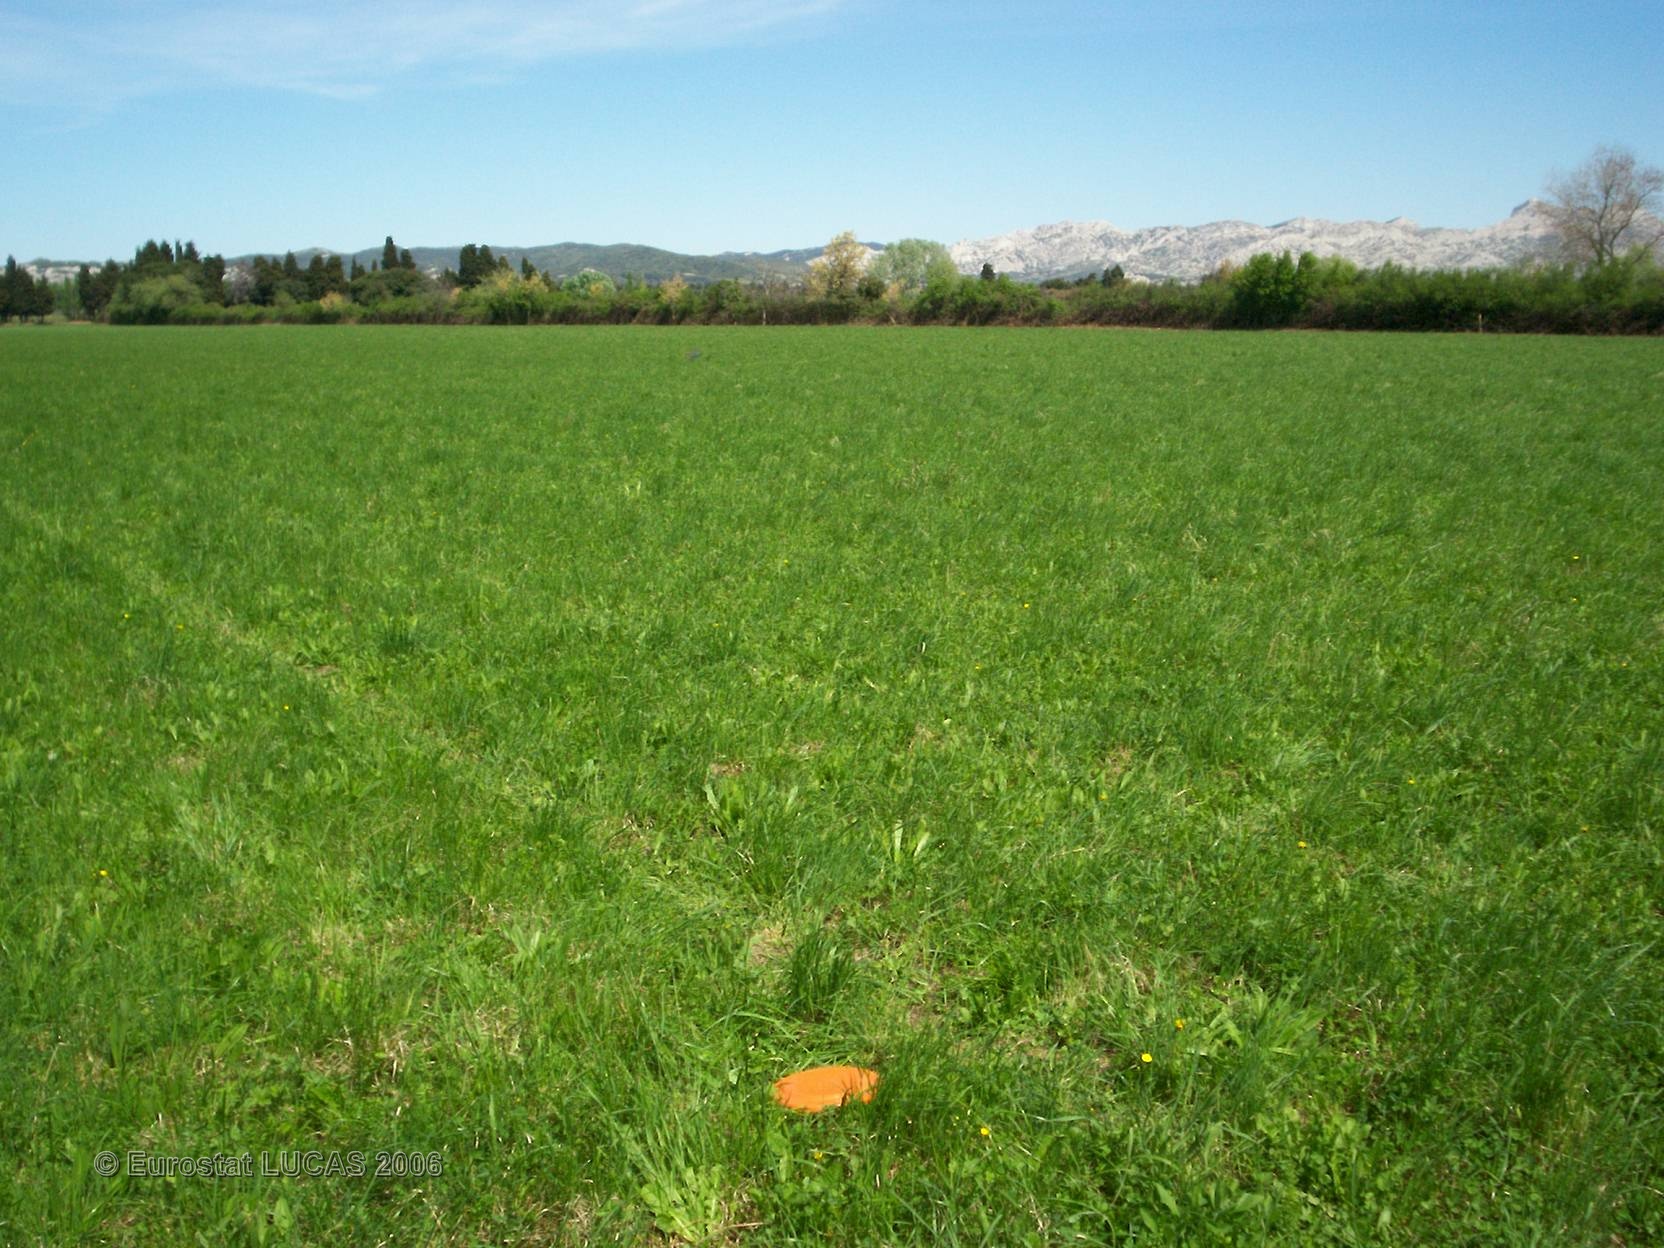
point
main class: Grassland
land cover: Grassland without tree/shrub cover
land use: Agriculture (excluding fallow land and kitchen gardens)
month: April
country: FR
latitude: 43.6835
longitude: 4.9109
